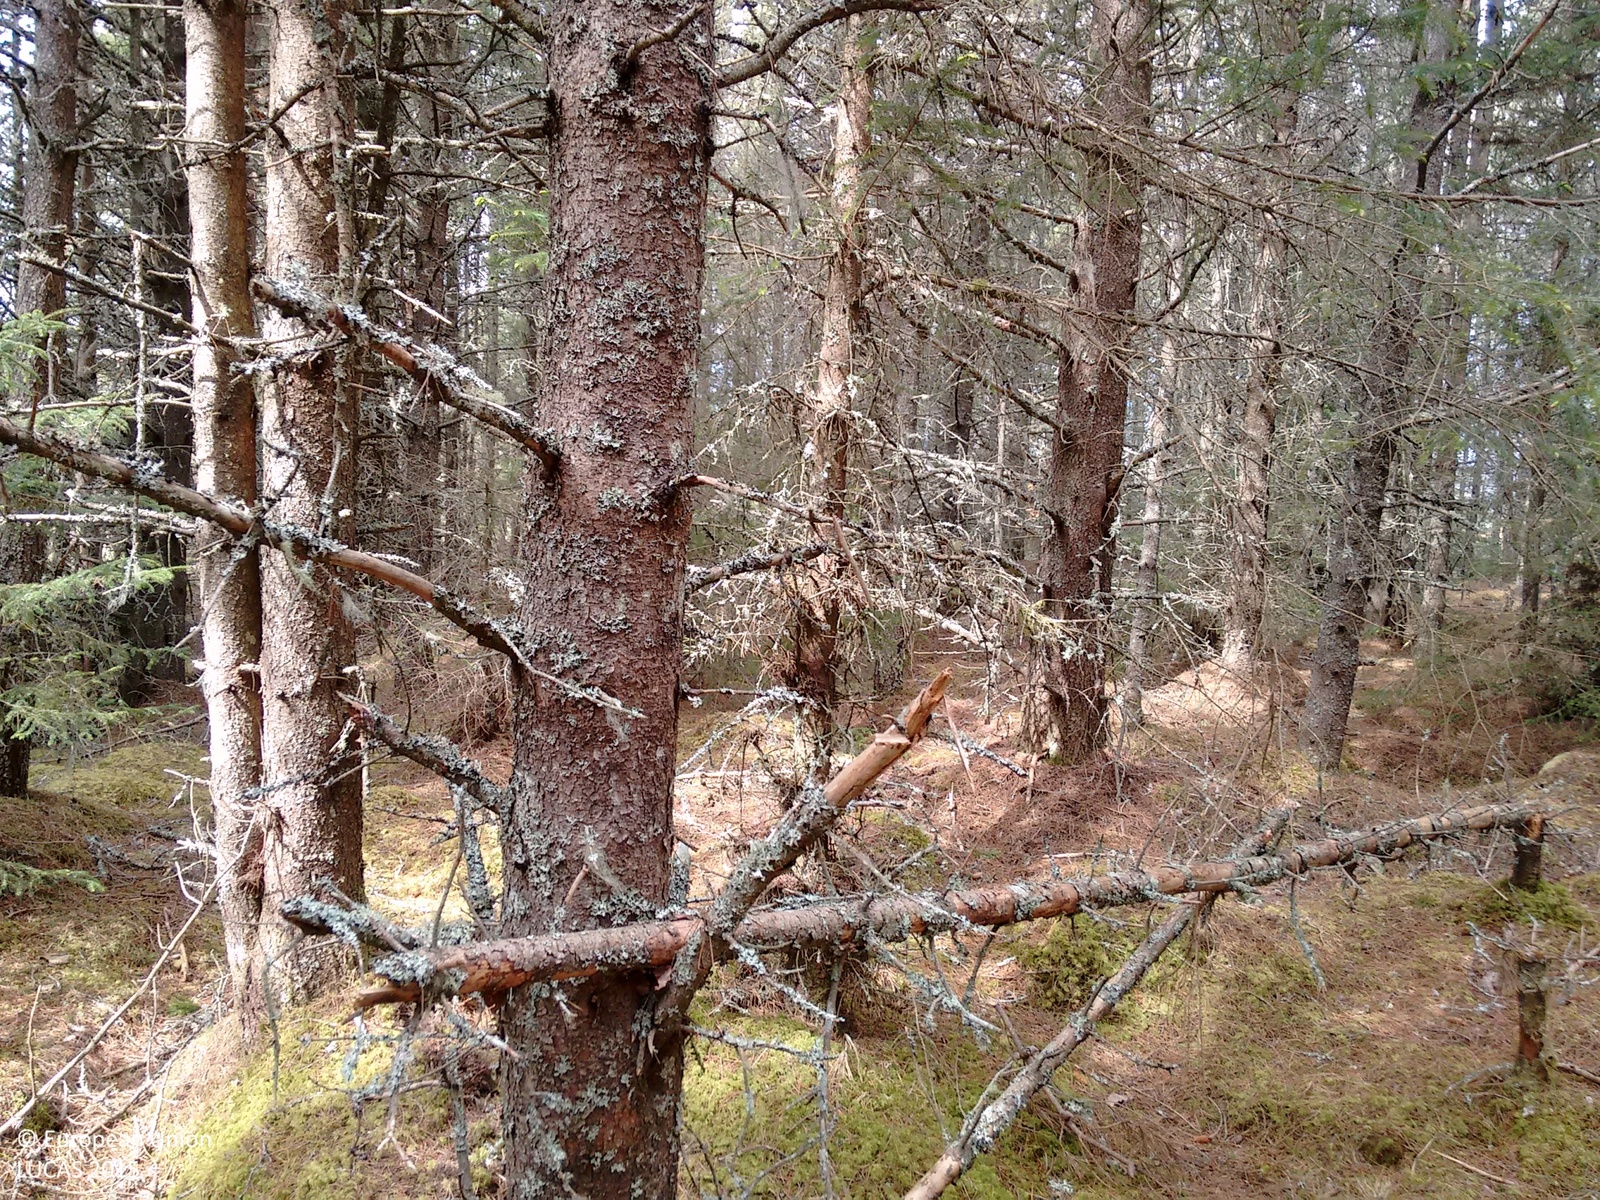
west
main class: Woodland
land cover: Spruce dominated coniferous woodland
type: exotic forest
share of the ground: > 75 %
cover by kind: coniferous forest trees 85 %, lichens and mosses 15 %
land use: Forestry
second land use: Amenities, museums, leisure
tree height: > 5 m
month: June
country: GB
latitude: 57.1816
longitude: -3.7247
